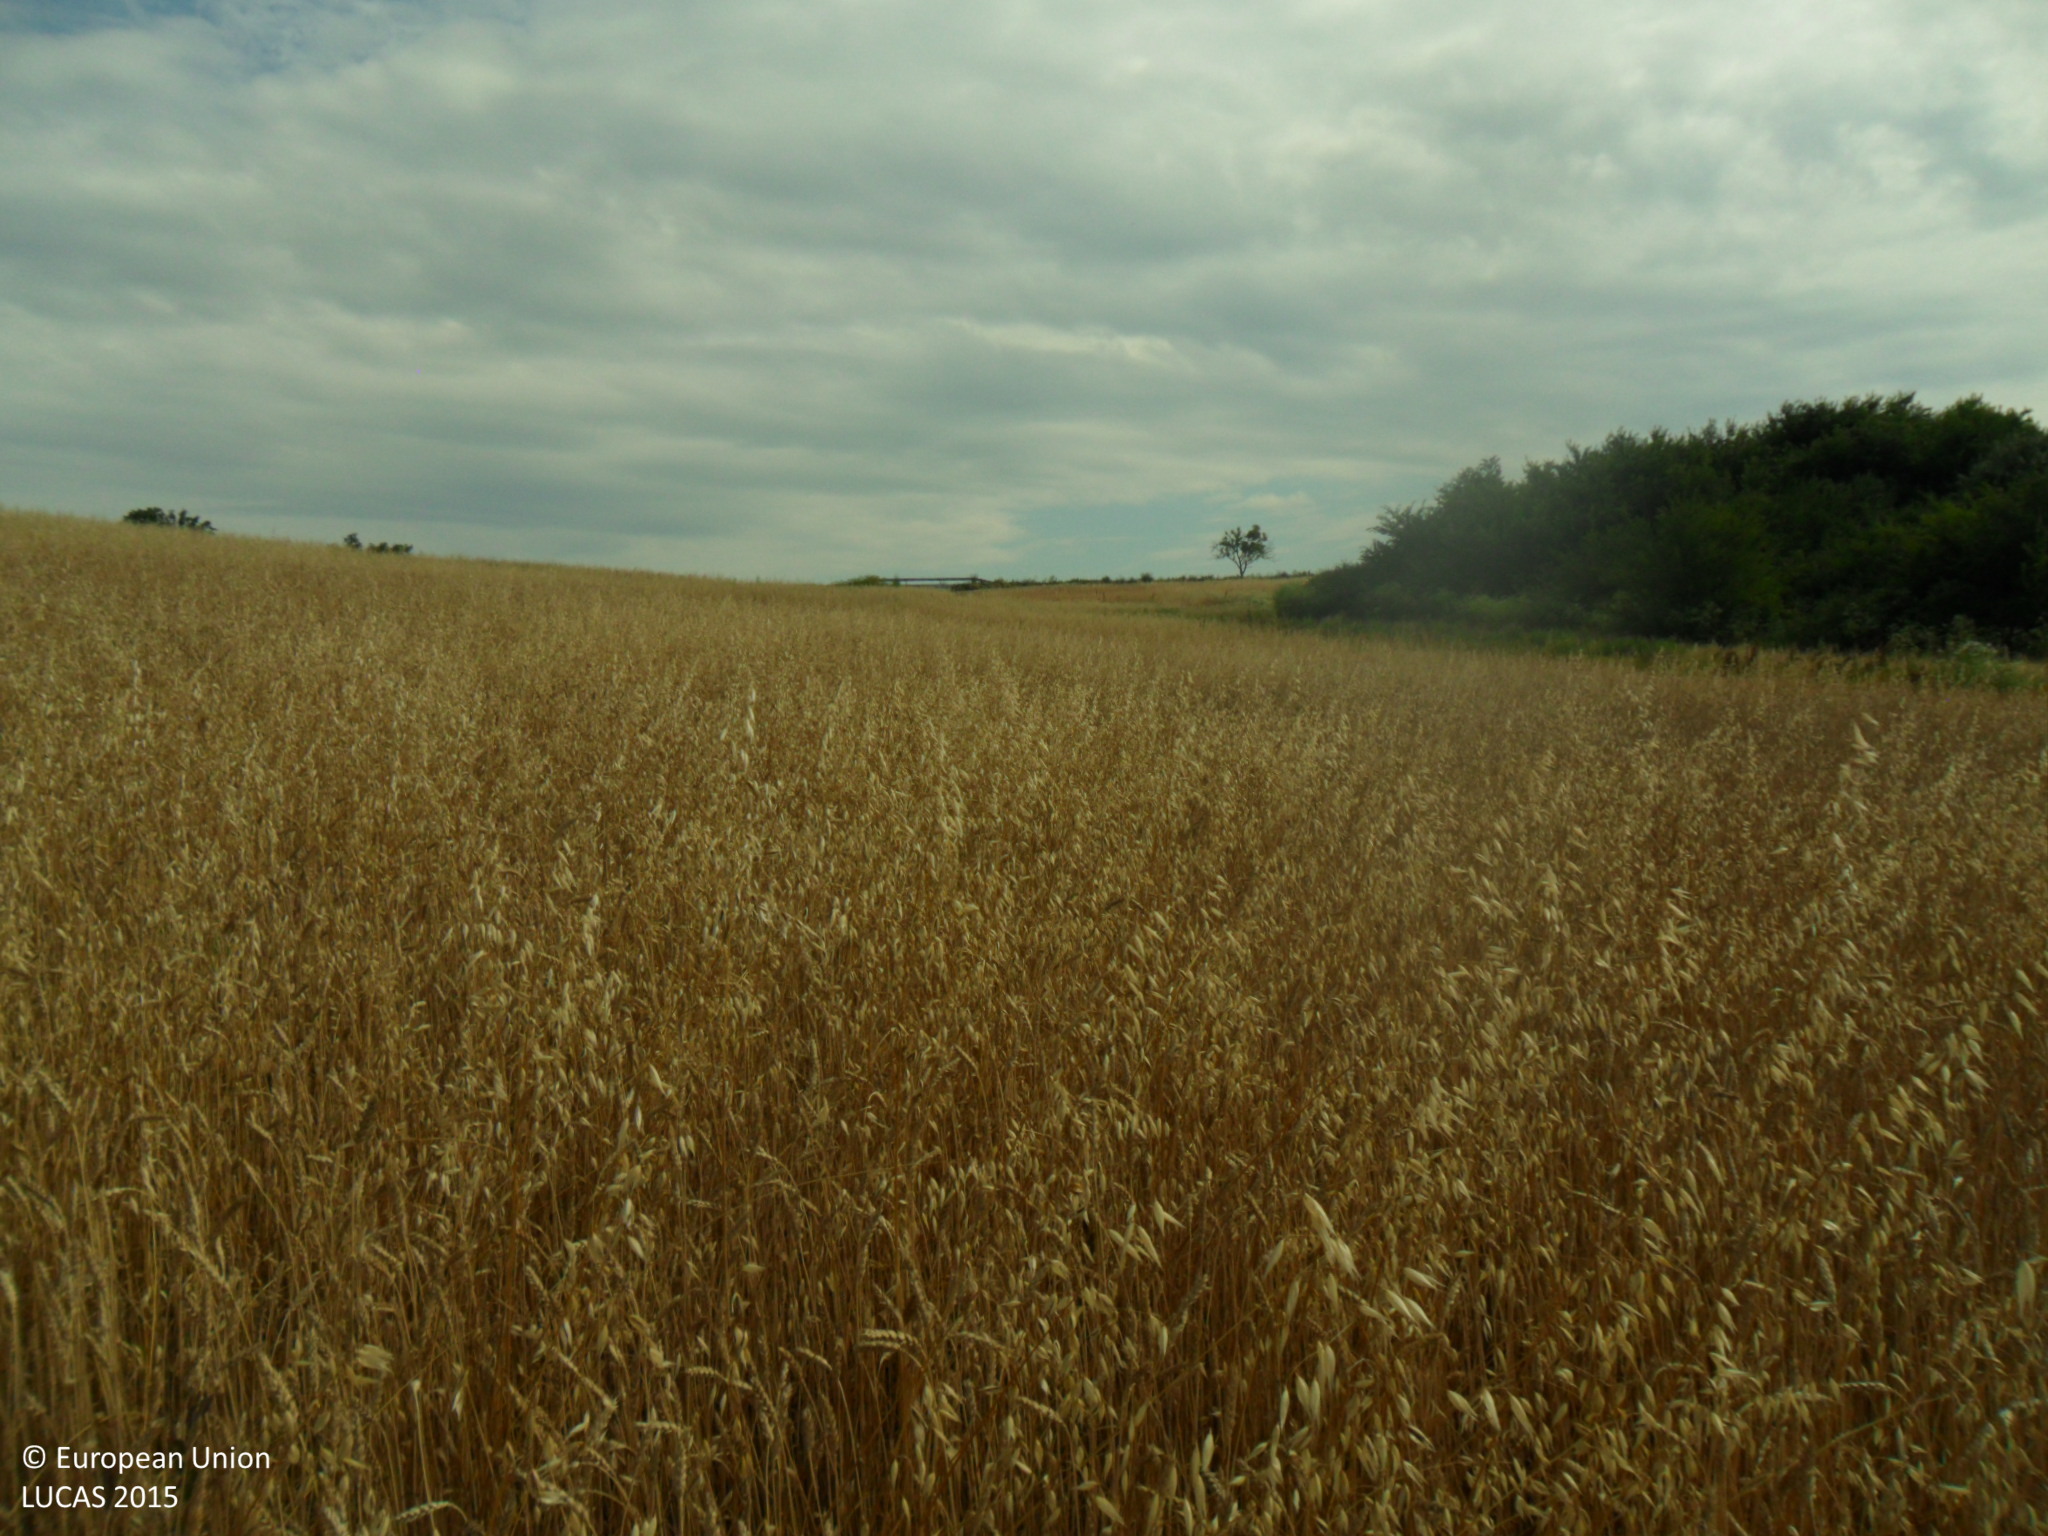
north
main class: Cropland
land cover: Common wheat
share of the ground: > 75 %
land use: Agriculture (excluding fallow land and kitchen gardens)
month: June
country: BG
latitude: 43.3937
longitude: 26.7899
